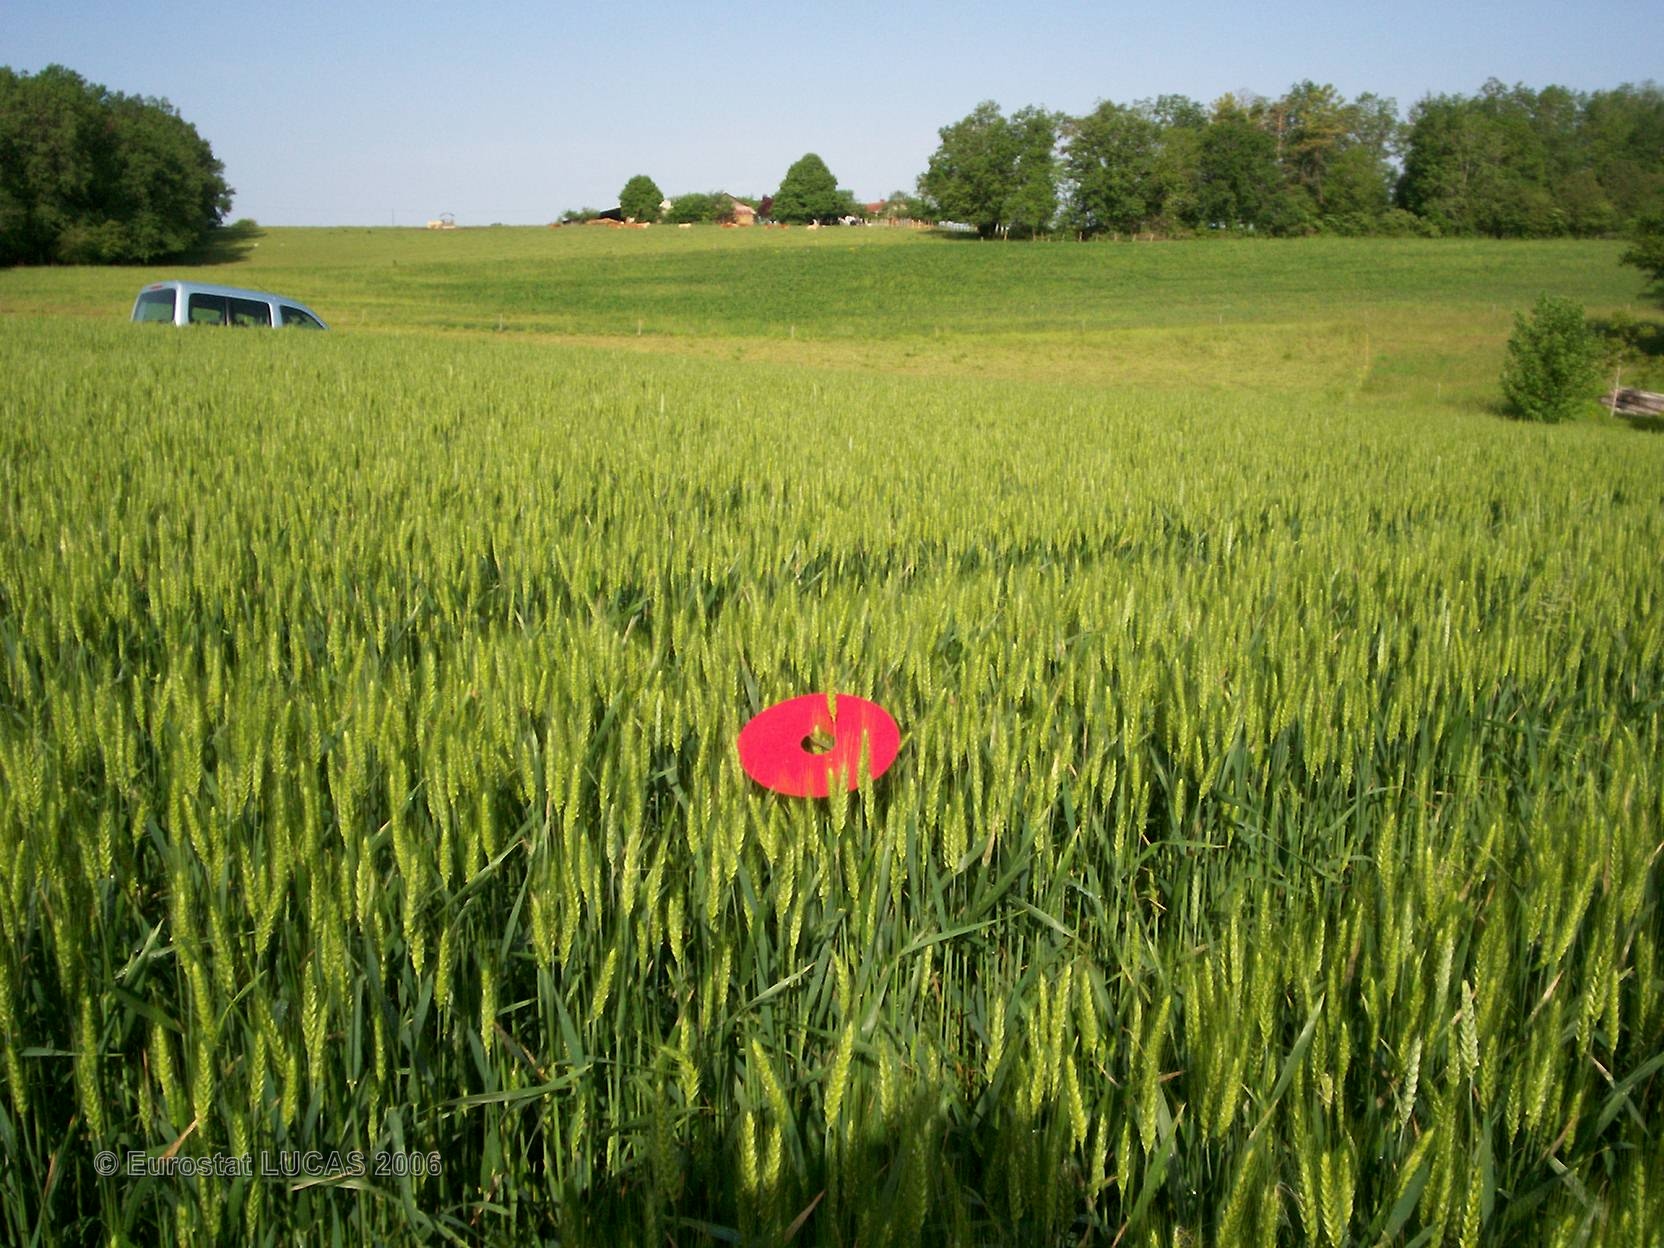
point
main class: Cropland
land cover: Triticale
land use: Agriculture (excluding fallow land and kitchen gardens)
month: May
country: FR
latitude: 45.3233
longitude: 0.6374
